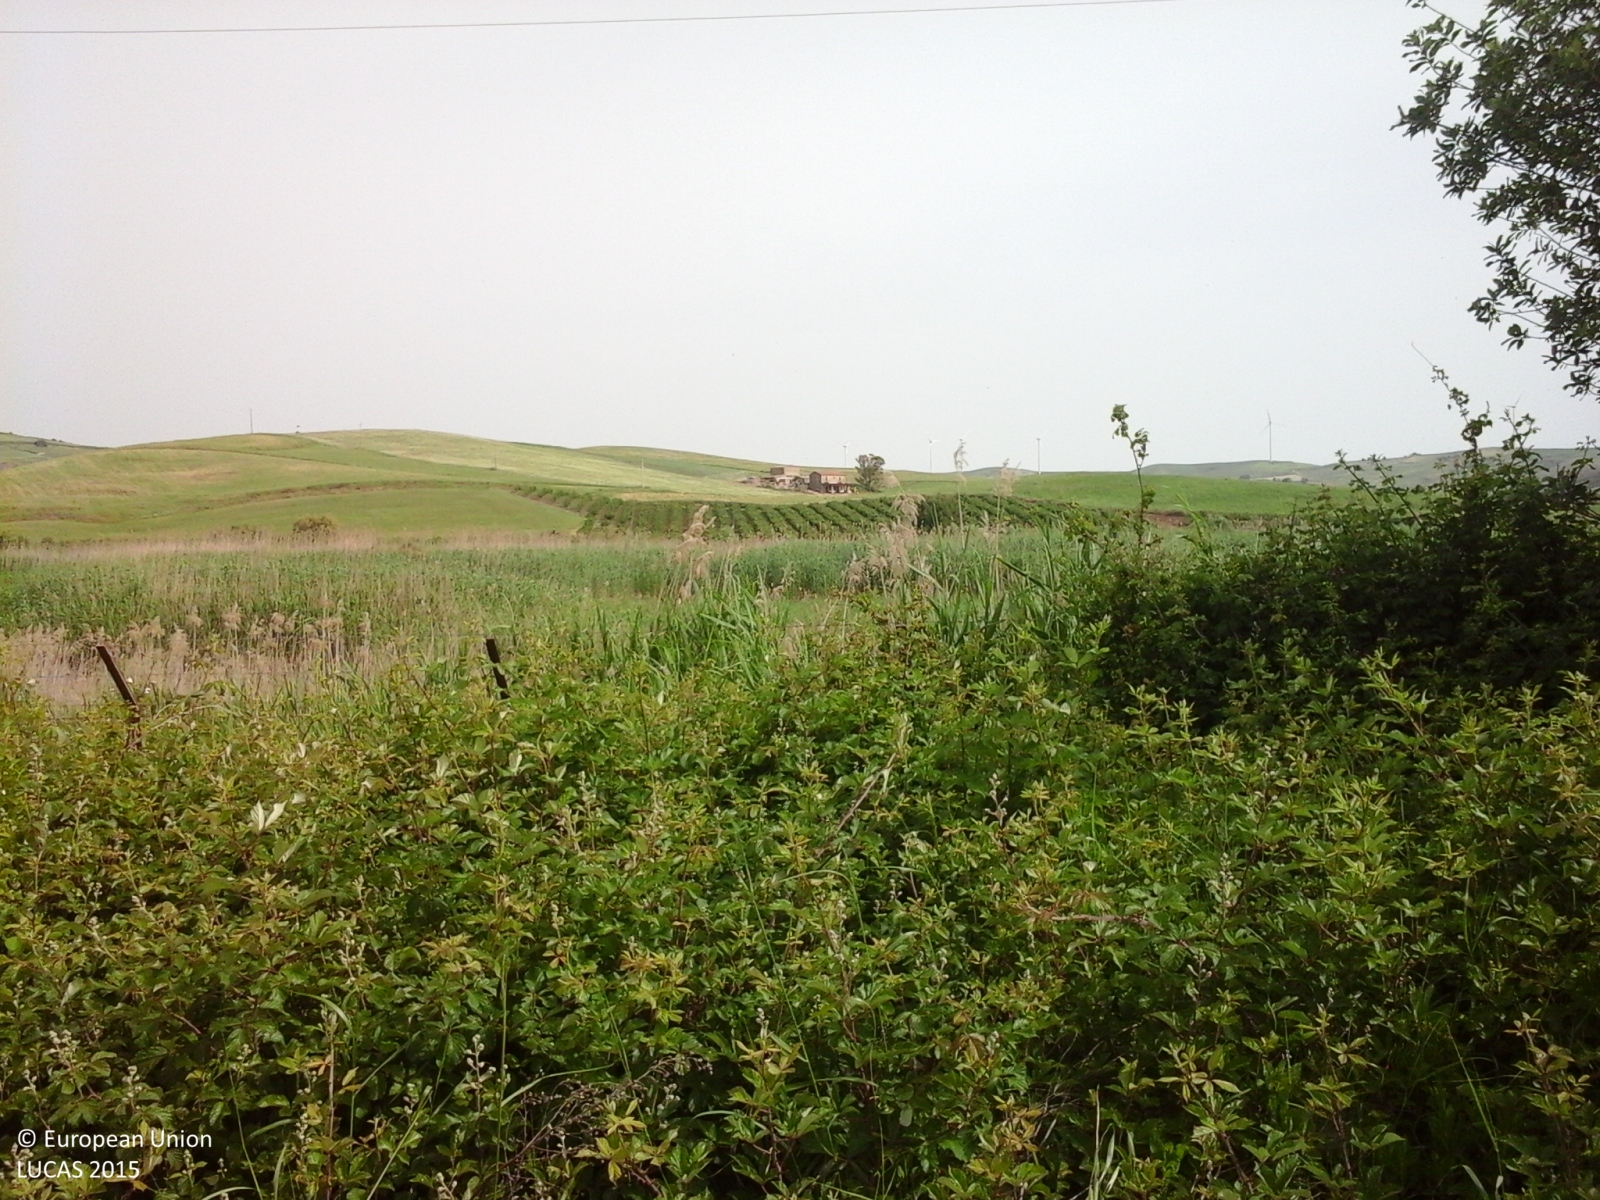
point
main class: Grassland
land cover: Grassland without tree/shrub cover
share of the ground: > 75 %
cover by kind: herbaceous plants 95 %, shrubs 5 %
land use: Abandoned areas
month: May
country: IT
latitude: 37.6780
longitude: 13.6355
